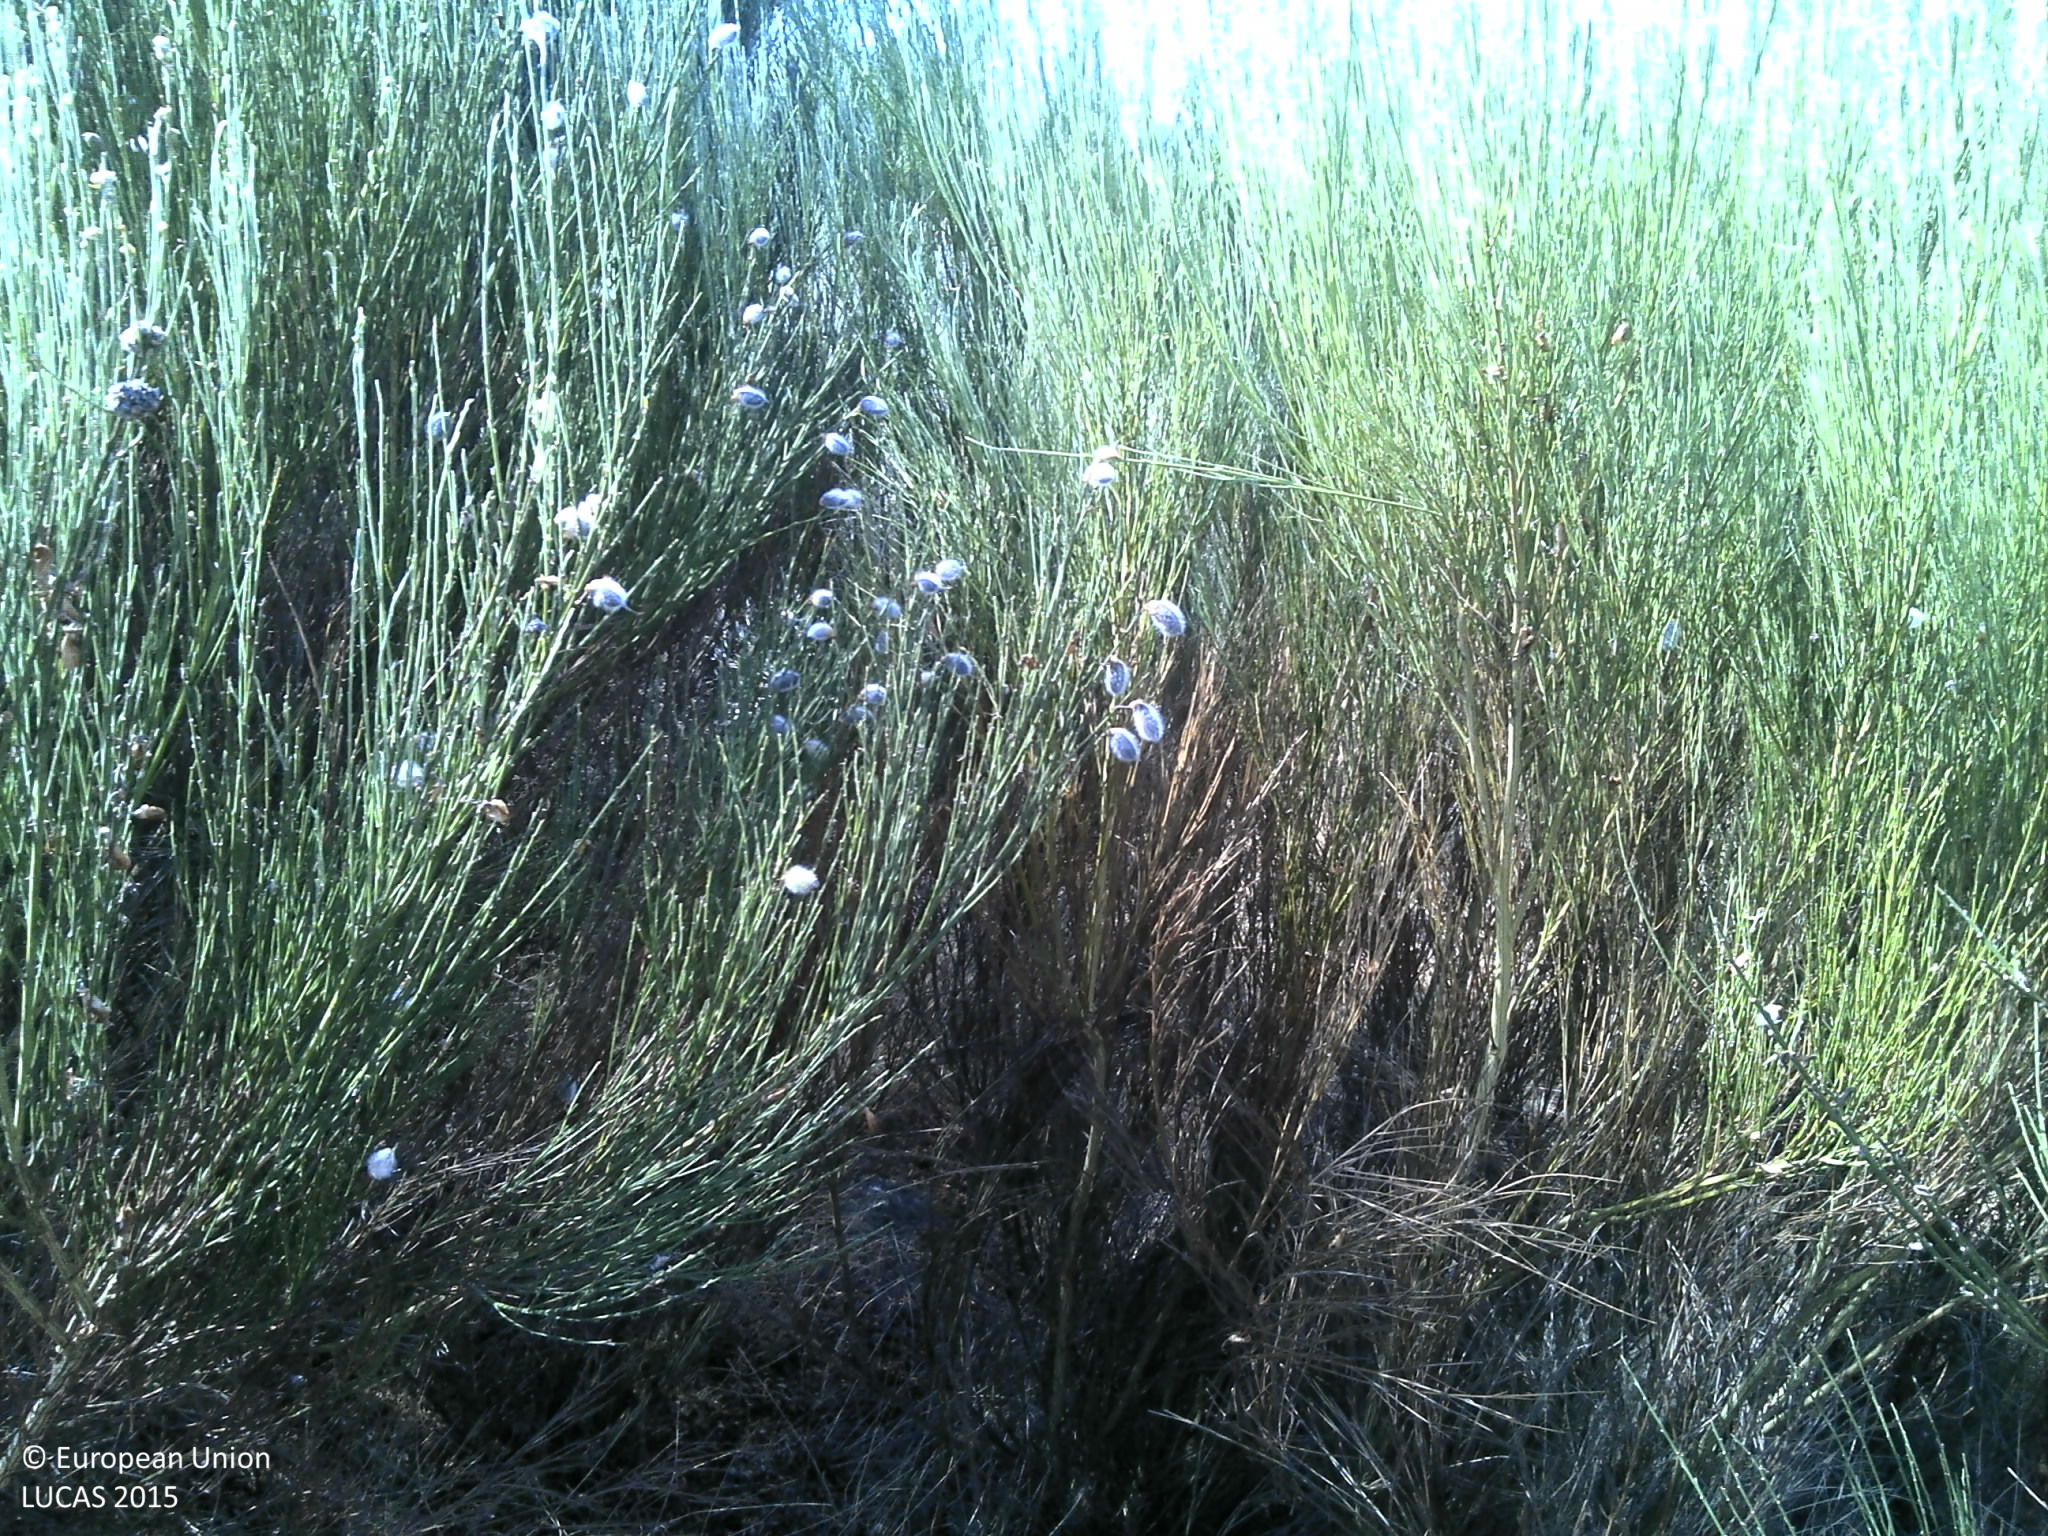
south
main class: Shrubland
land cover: Shrubland with sparse tree cover
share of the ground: 50 - 75 %
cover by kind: shrubs 60 %, herbaceous plants 25 %, coniferous forest trees 5 %, consolidated bare surface 5 %, unconsolidated bare surface 5 %
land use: Semi-natural and natural areas not in use
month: July
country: PT
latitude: 40.8228
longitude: -7.3889
